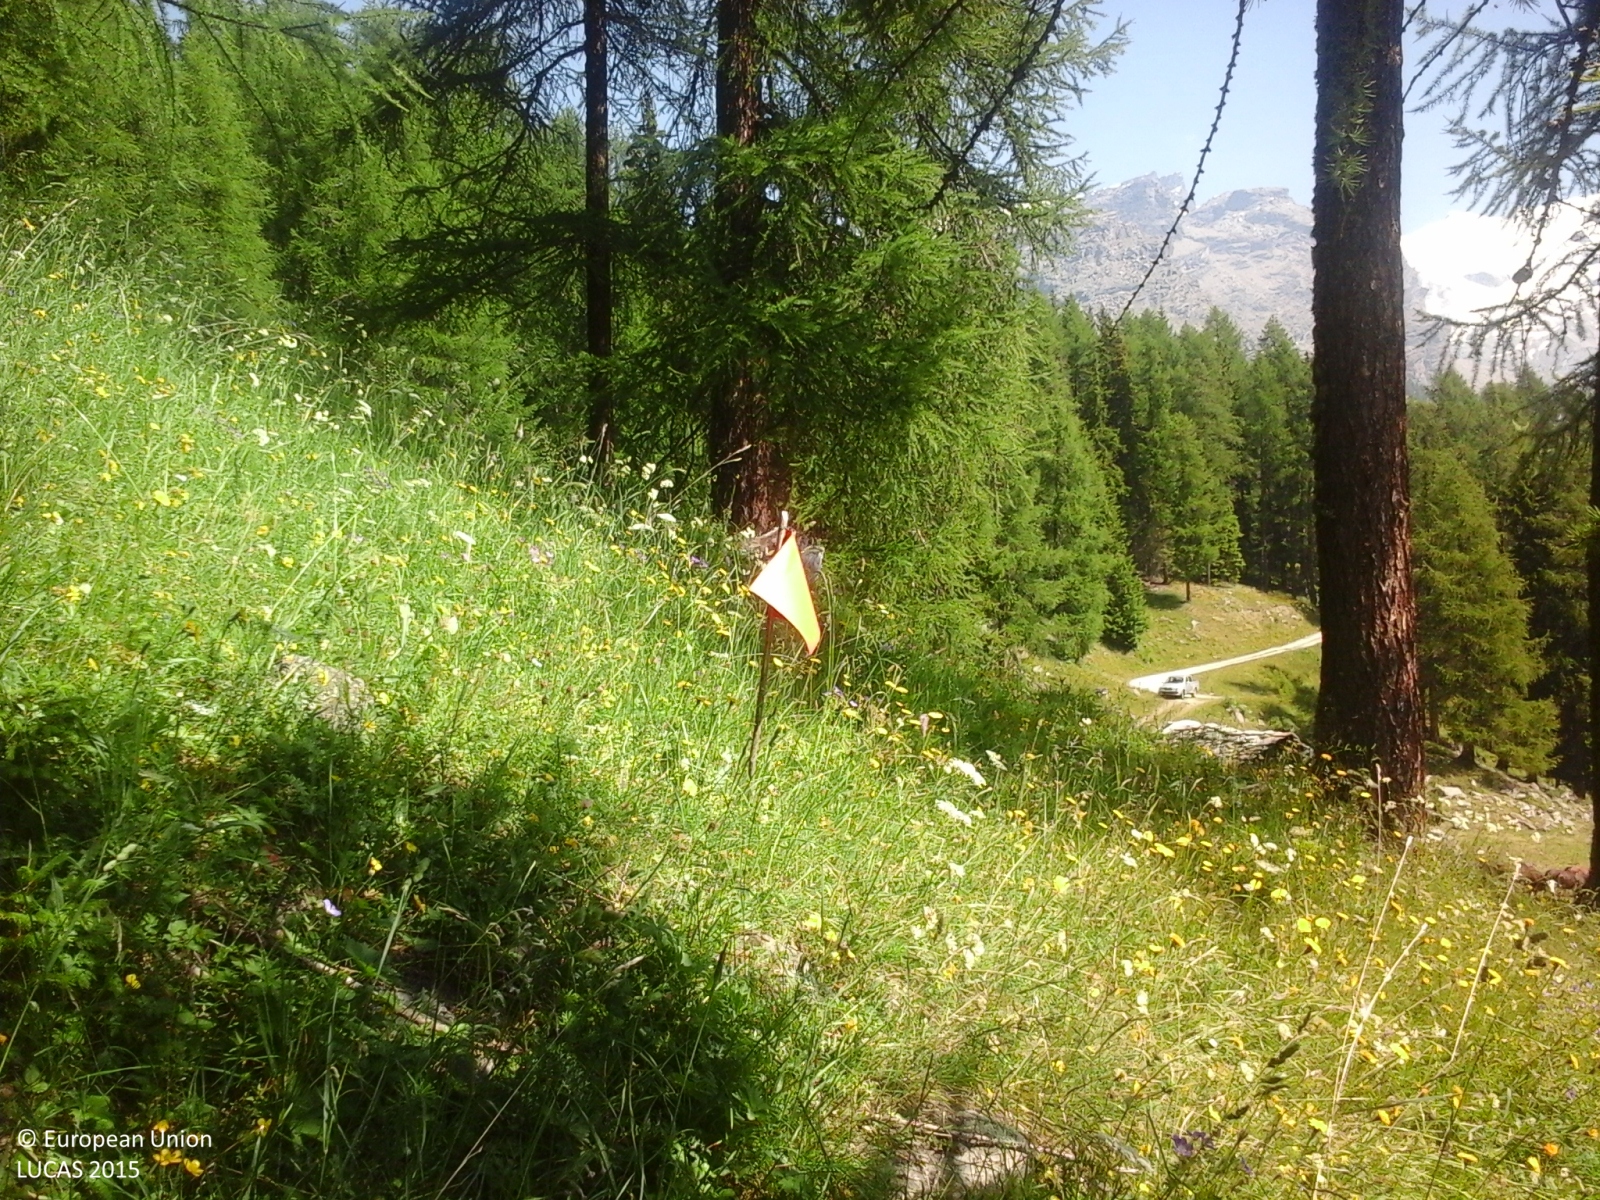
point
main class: Woodland
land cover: Other coniferous woodland
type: alpine coniferous forest
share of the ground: > 75 %
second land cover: Grassland without tree/shrub cover
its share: > 75 %
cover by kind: coniferous forest trees 70 %, herbaceous plants 30 %
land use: Forestry
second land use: Agriculture (excluding fallow land and kitchen gardens)
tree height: > 5 m
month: July
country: IT
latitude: 45.8584
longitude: 7.7235
